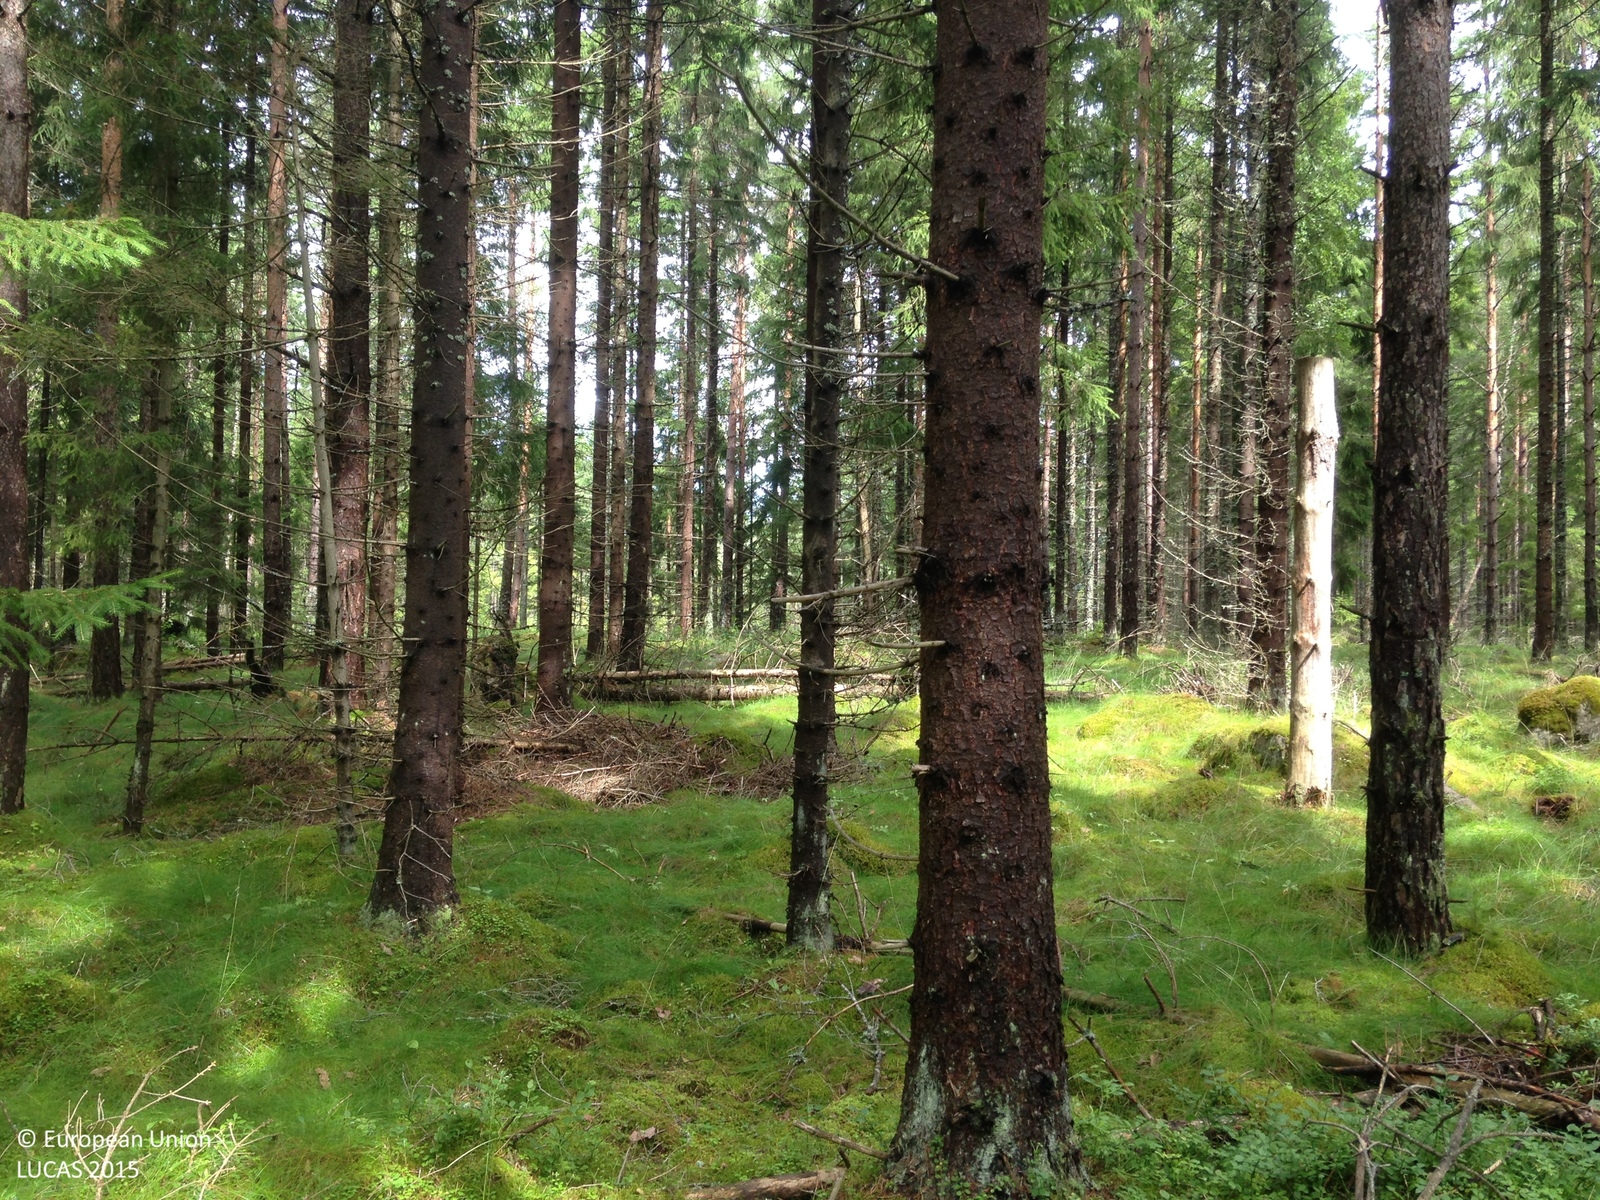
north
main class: Woodland
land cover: Other coniferous woodland
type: boreal forest
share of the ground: 25 - 50 %
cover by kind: coniferous forest trees 40 %, herbaceous plants 35 %, lichens and mosses 20 %, broadleaved forest trees 5 %
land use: Forestry
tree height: > 5 m
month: July
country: SE
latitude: 58.9946
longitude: 14.3957
